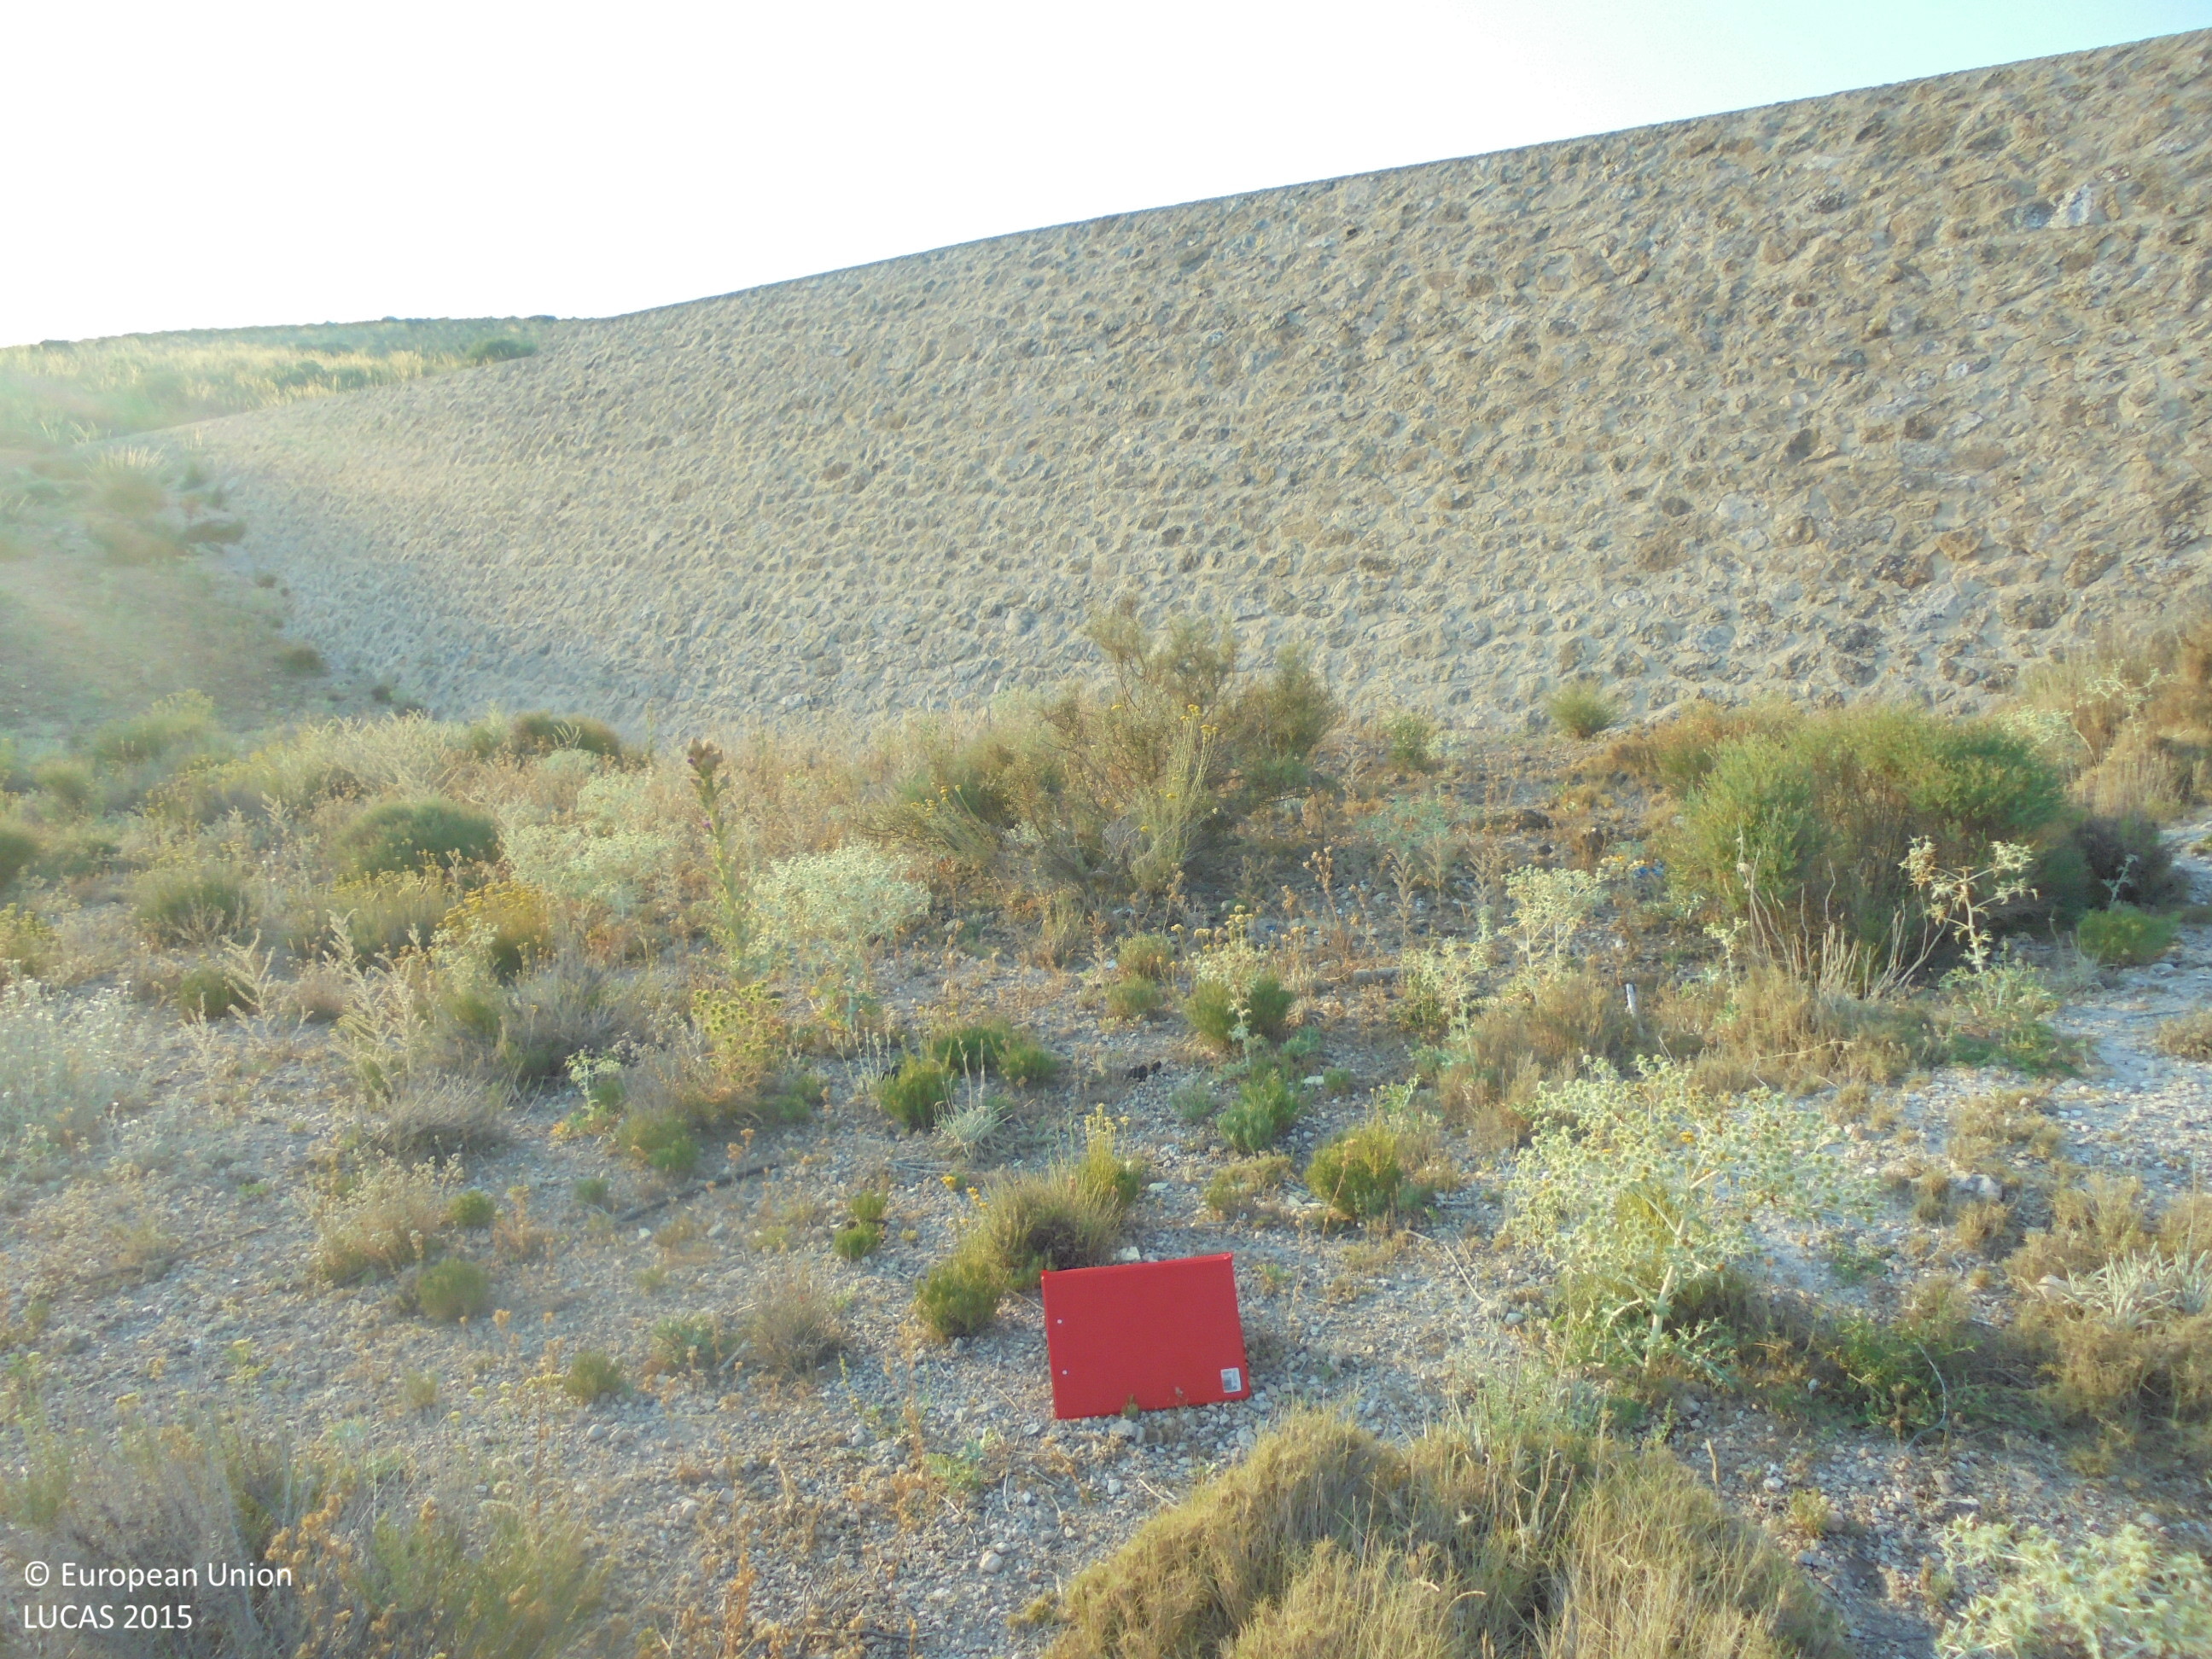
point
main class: Shrubland
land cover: Shrubland without tree cover
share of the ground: 25 - 50 %
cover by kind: herbaceous plants 40 %, shrubs 30 %, unconsolidated bare surface 30 %
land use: Semi-natural and natural areas not in use
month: July
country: ES
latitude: 38.7041
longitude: -1.4124
